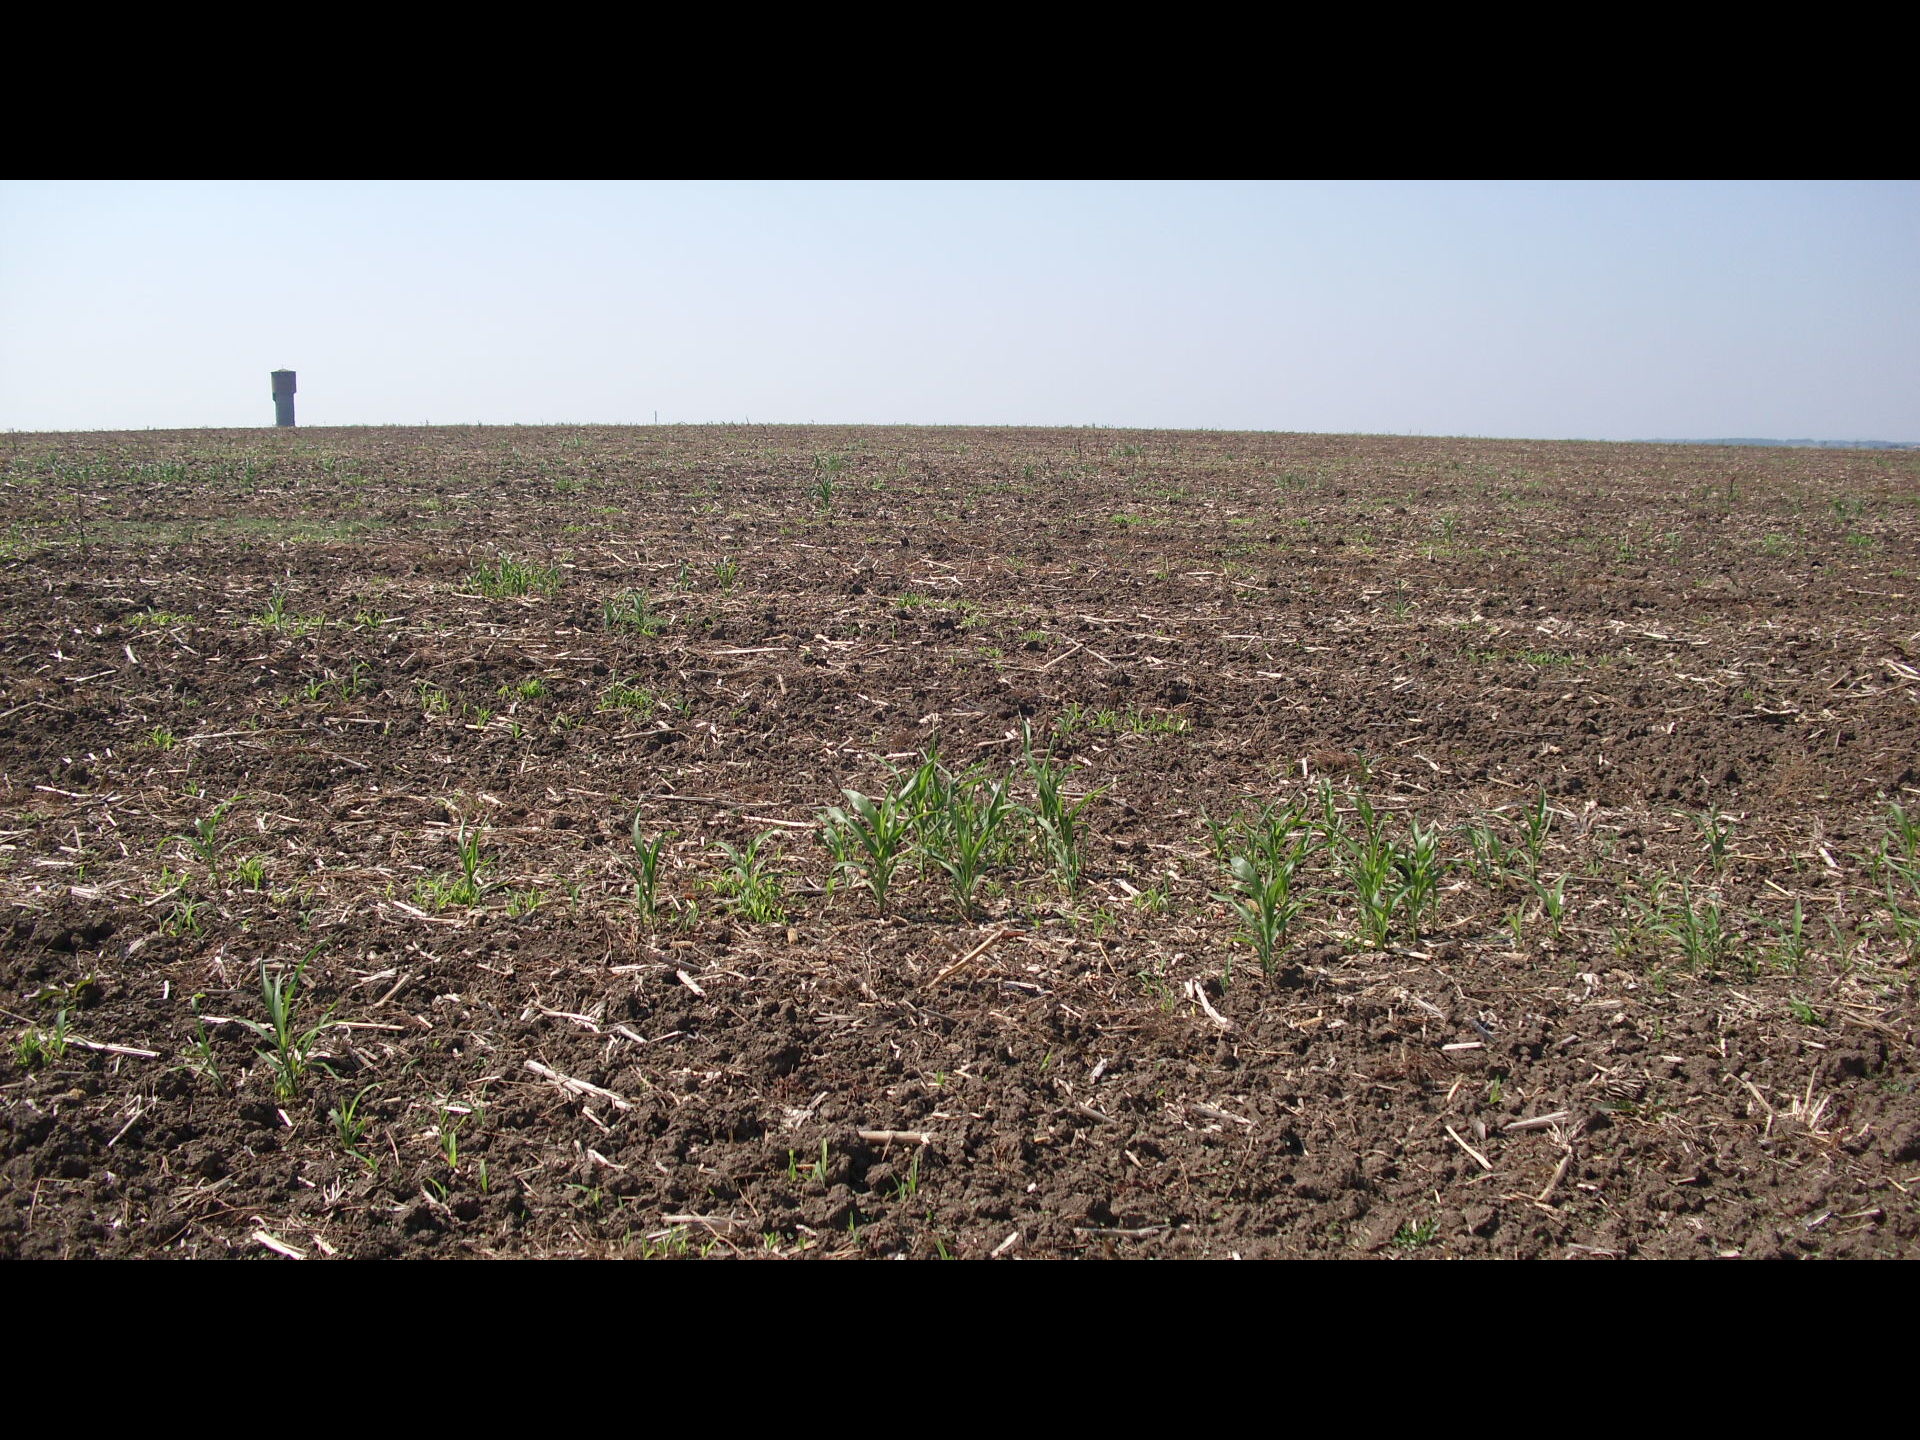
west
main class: Cropland
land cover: Maize
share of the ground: < 10 %
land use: Agriculture (excluding fallow land and kitchen gardens)
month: September
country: BG
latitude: 43.9906
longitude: 22.5160
